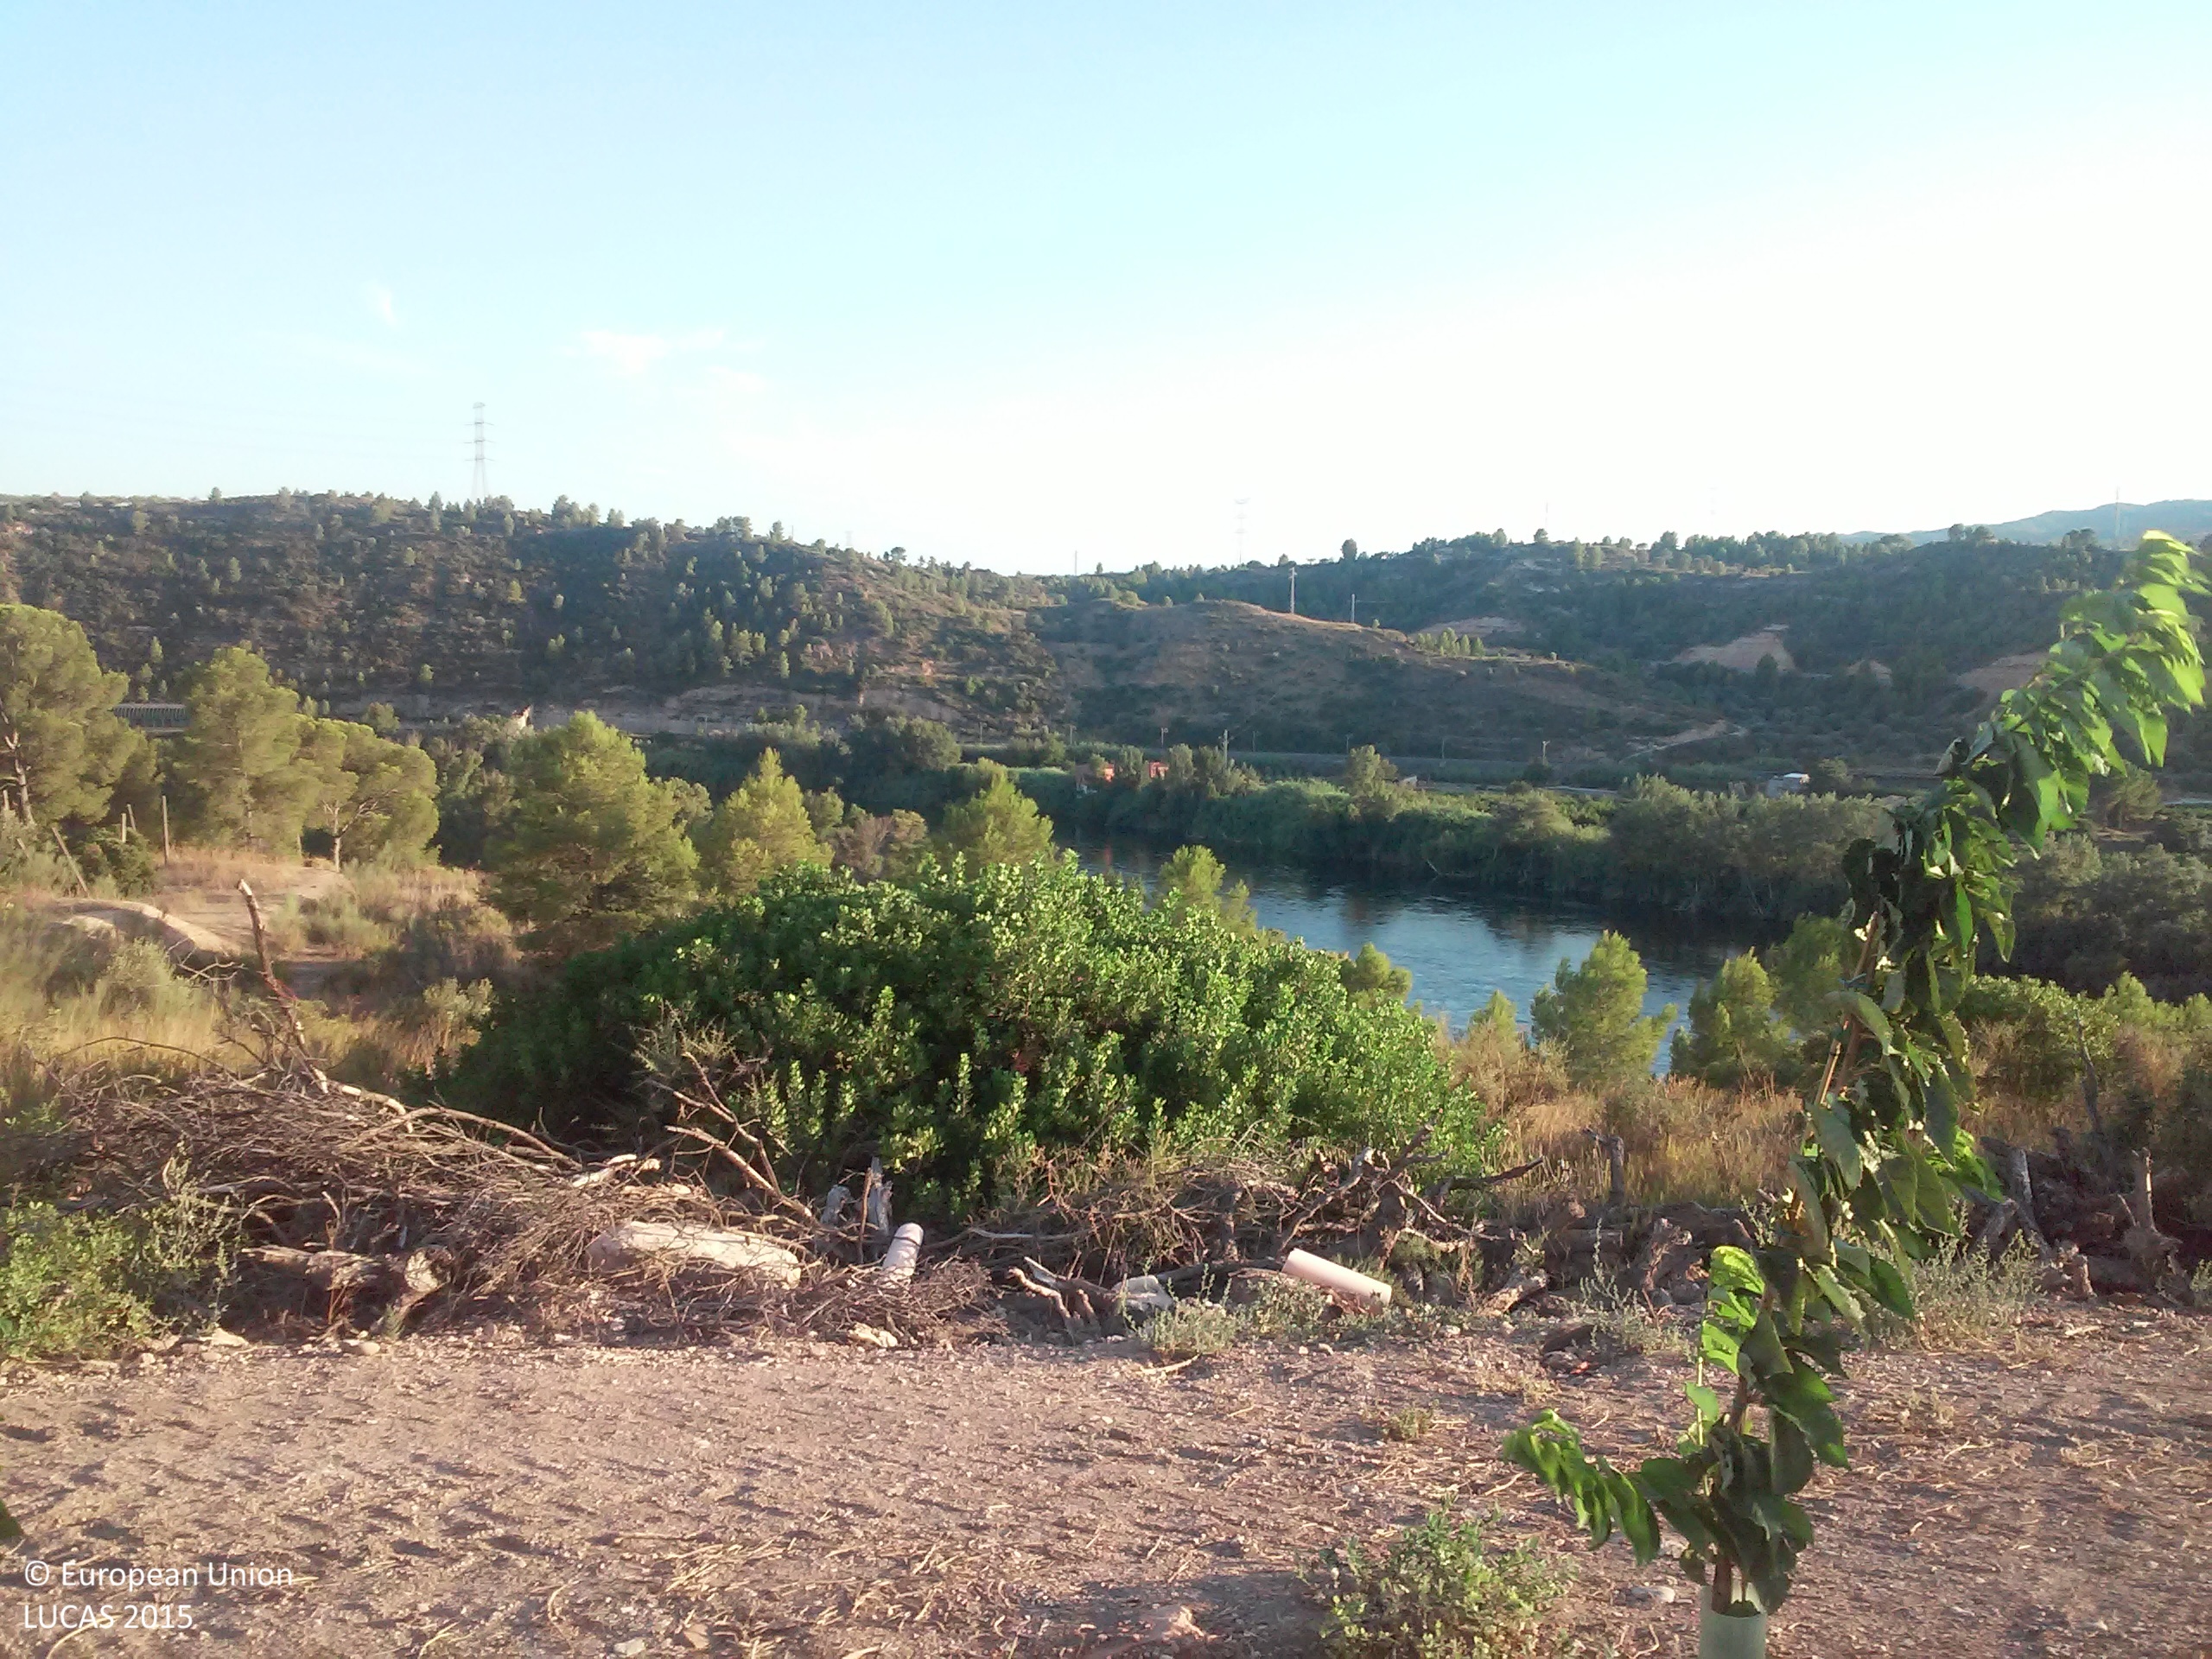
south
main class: Cropland
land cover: Other fruit trees and berries
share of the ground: < 10 %
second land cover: Spontaneously vegetated surfaces
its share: > 75 %
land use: Agriculture (excluding fallow land and kitchen gardens)
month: August
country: ES
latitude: 41.2121
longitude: 0.5565
